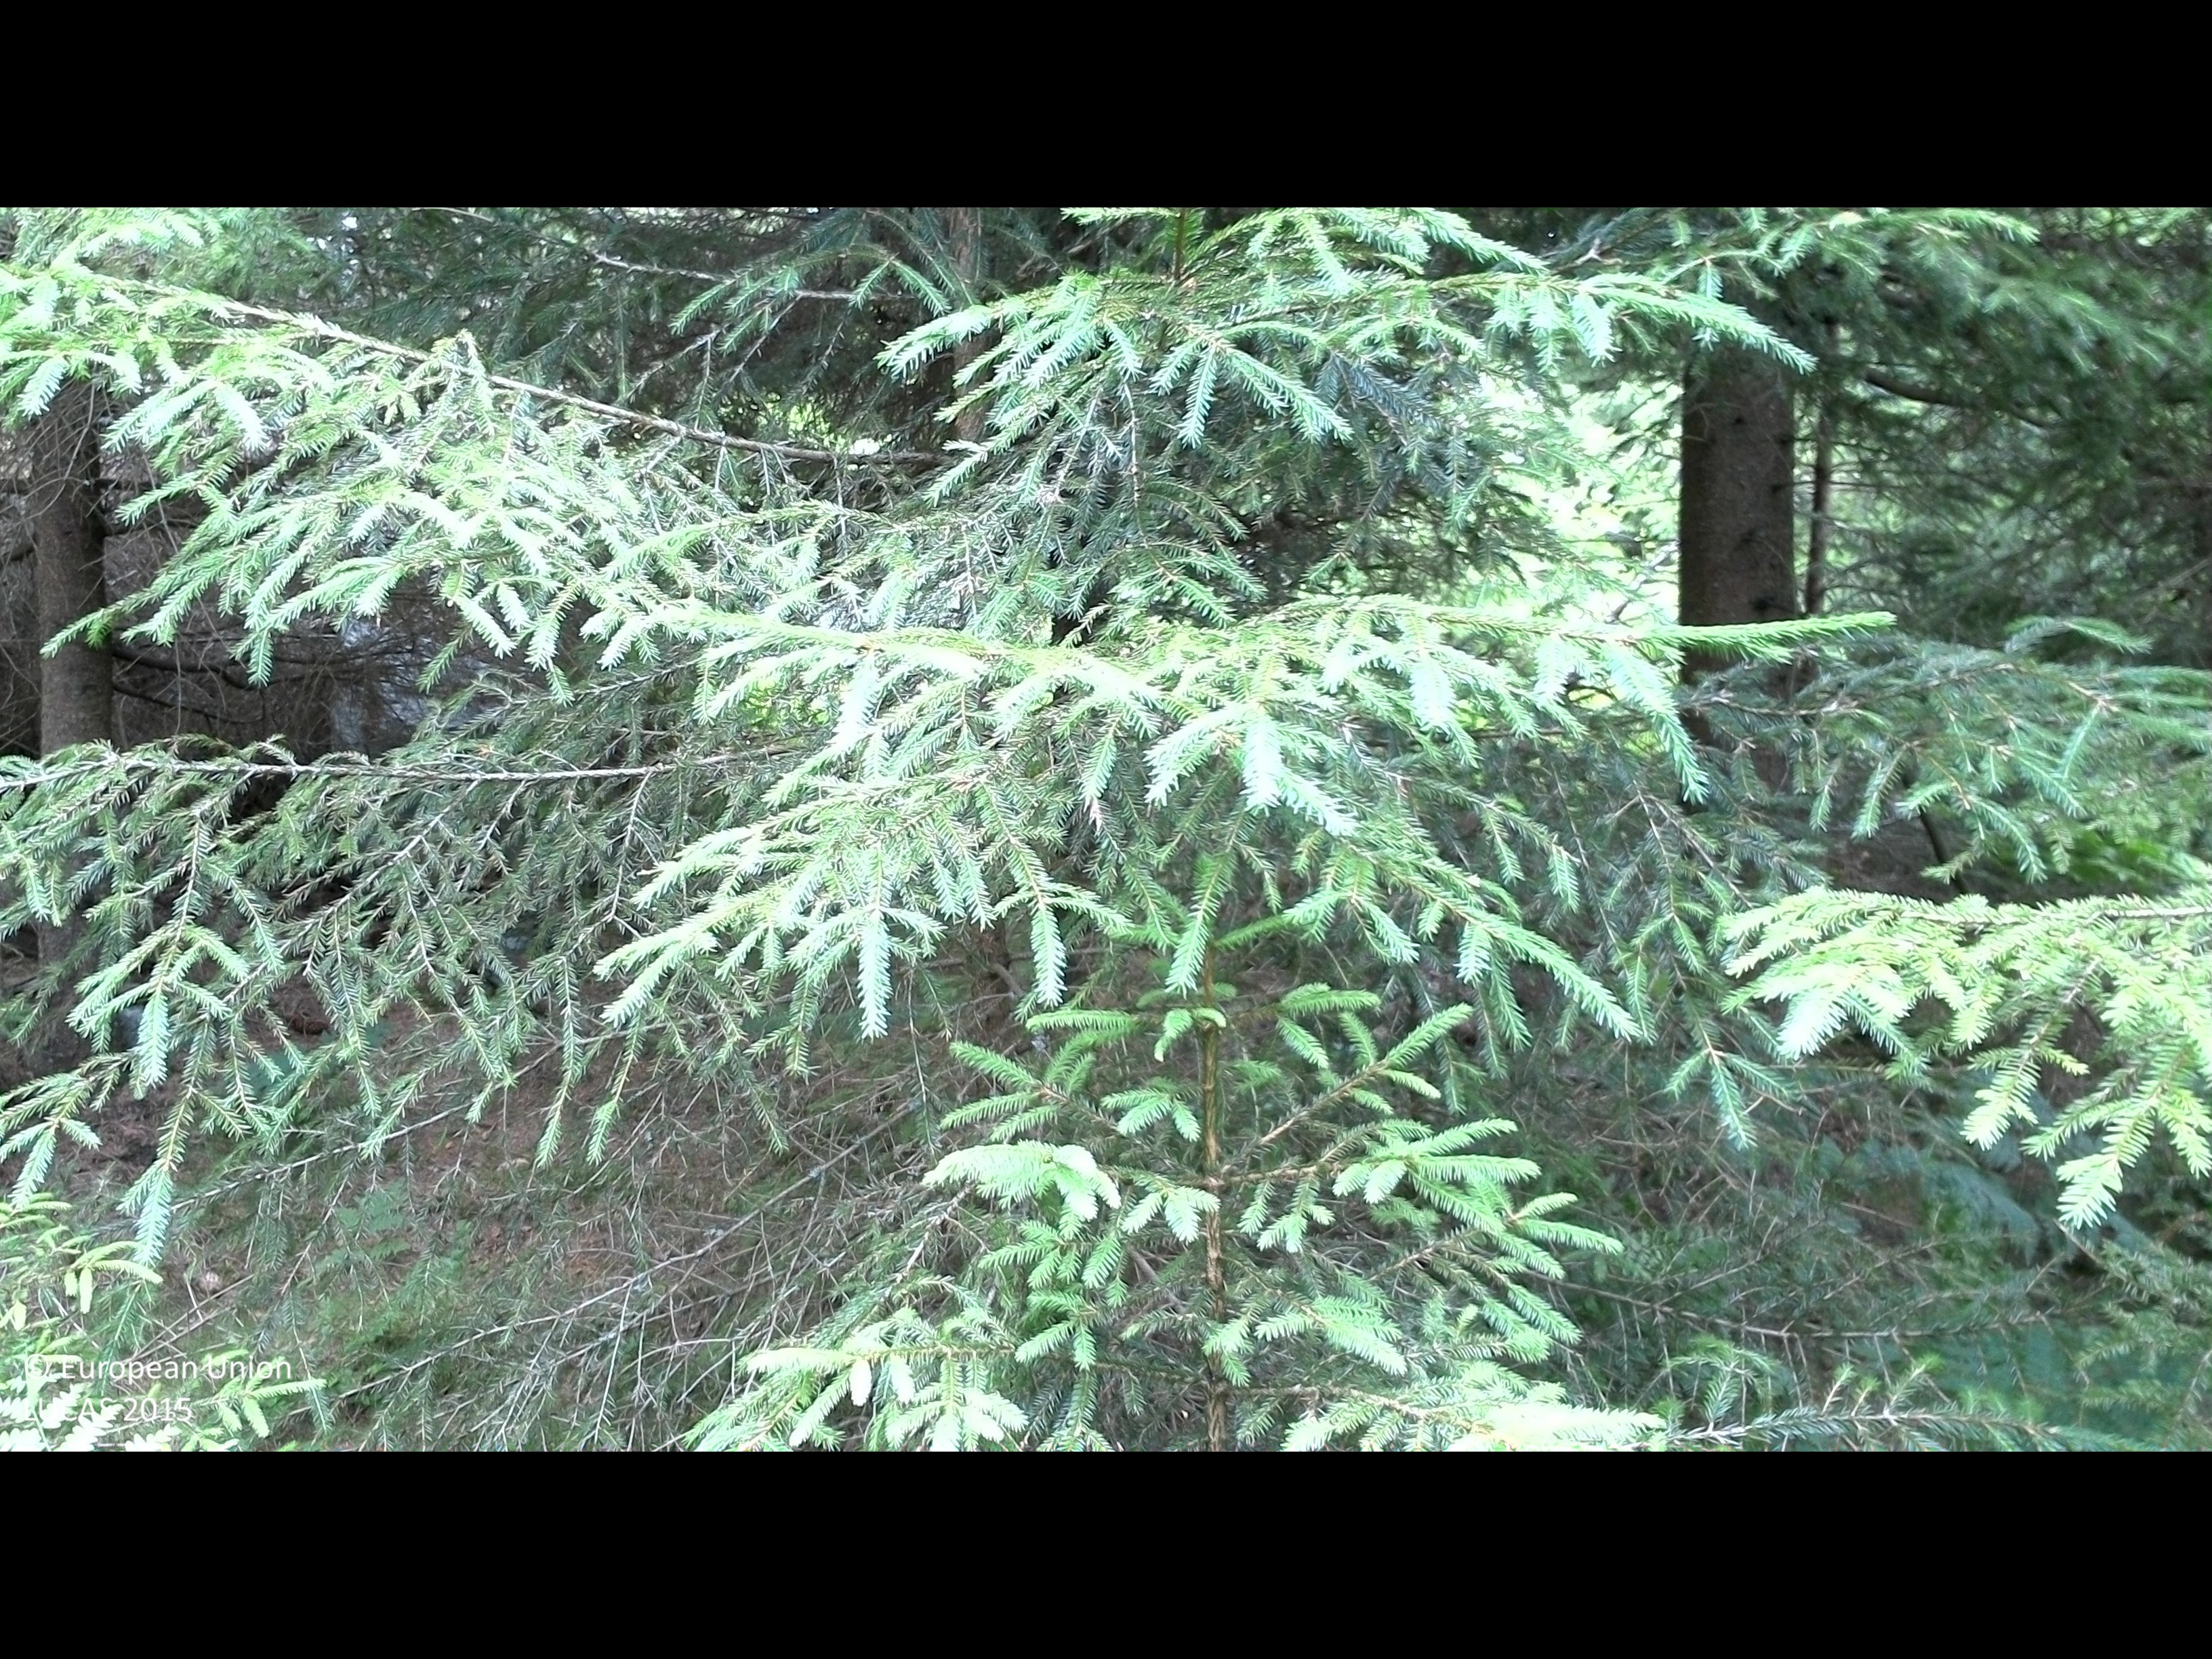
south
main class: Woodland
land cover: Spruce dominated coniferous woodland
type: boreal forest
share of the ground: > 75 %
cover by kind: coniferous forest trees 75 %, shrubs 10 %, herbaceous plants 10 %, broadleaved forest trees 5 %
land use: Forestry
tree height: < 5 m
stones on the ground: < 10 %
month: July
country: SE
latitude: 56.4959
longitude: 14.7571
